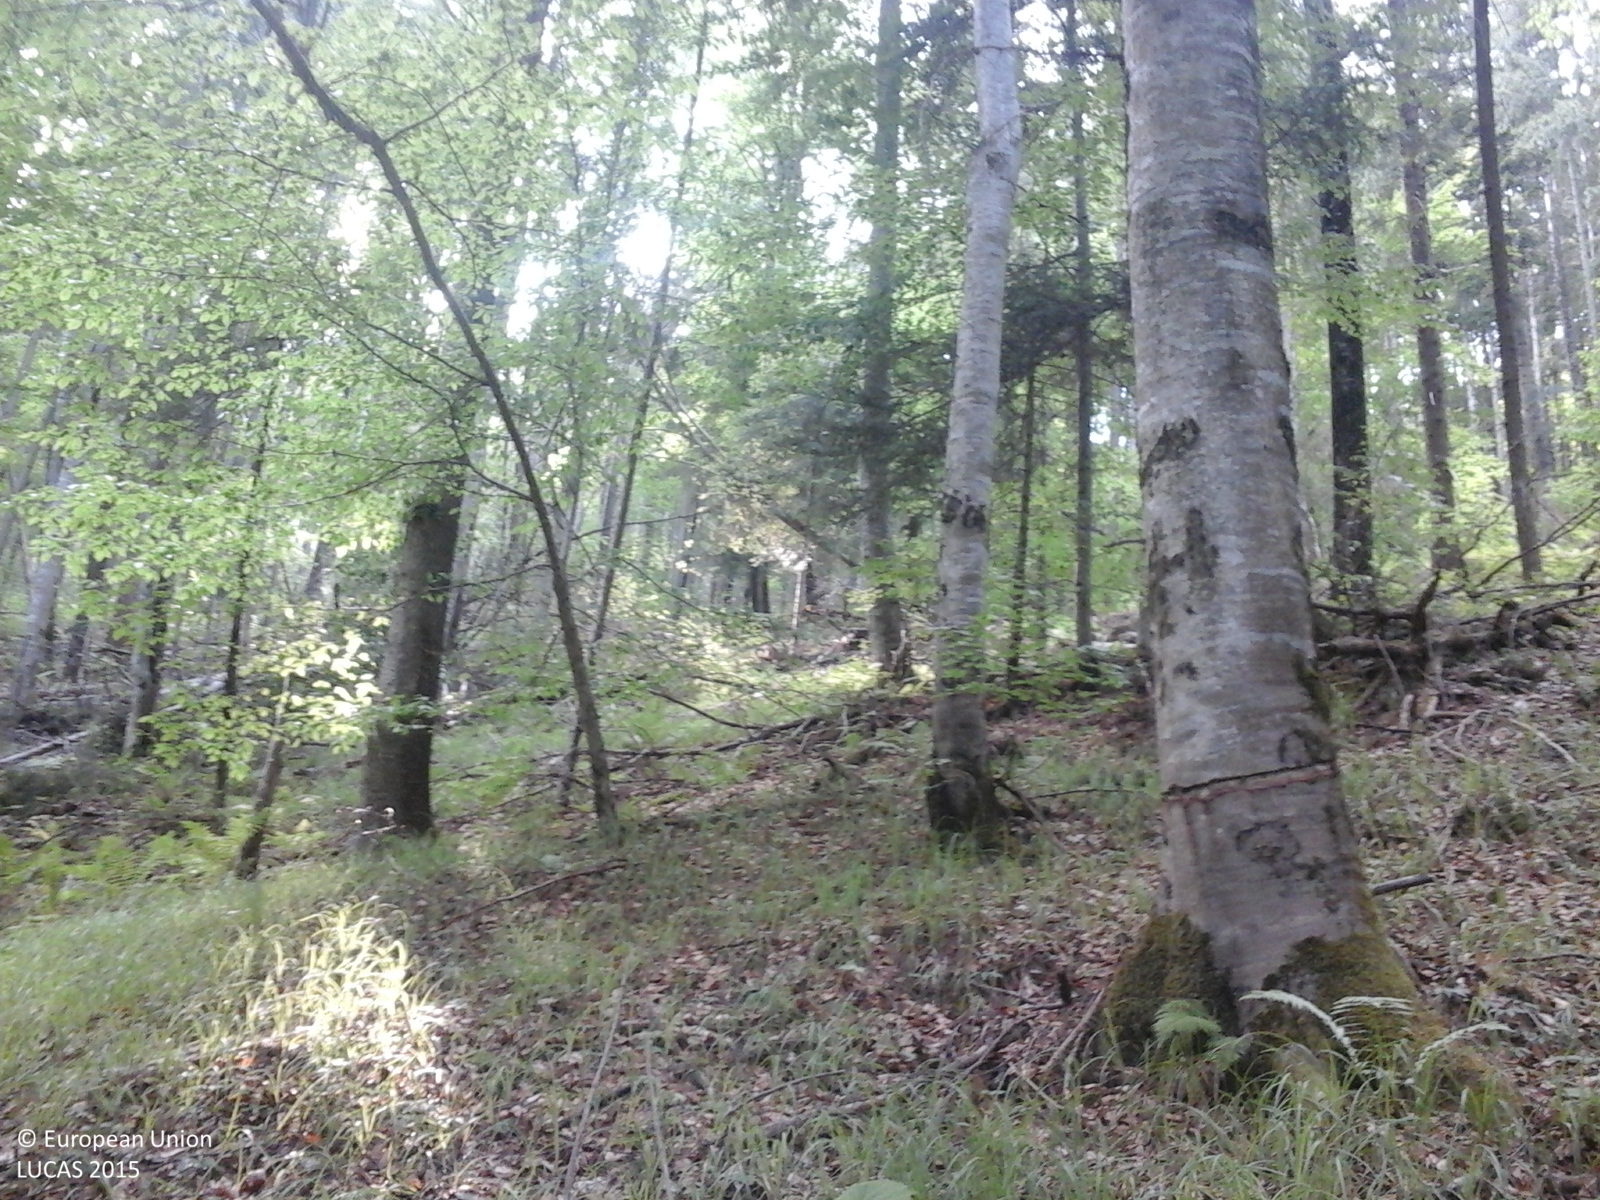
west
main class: Woodland
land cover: Broadleaved woodland
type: beech forest
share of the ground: > 75 %
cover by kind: broadleaved forest trees 100 %
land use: Forestry
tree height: > 5 m
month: June
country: RO
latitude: 46.7843
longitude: 26.1466
